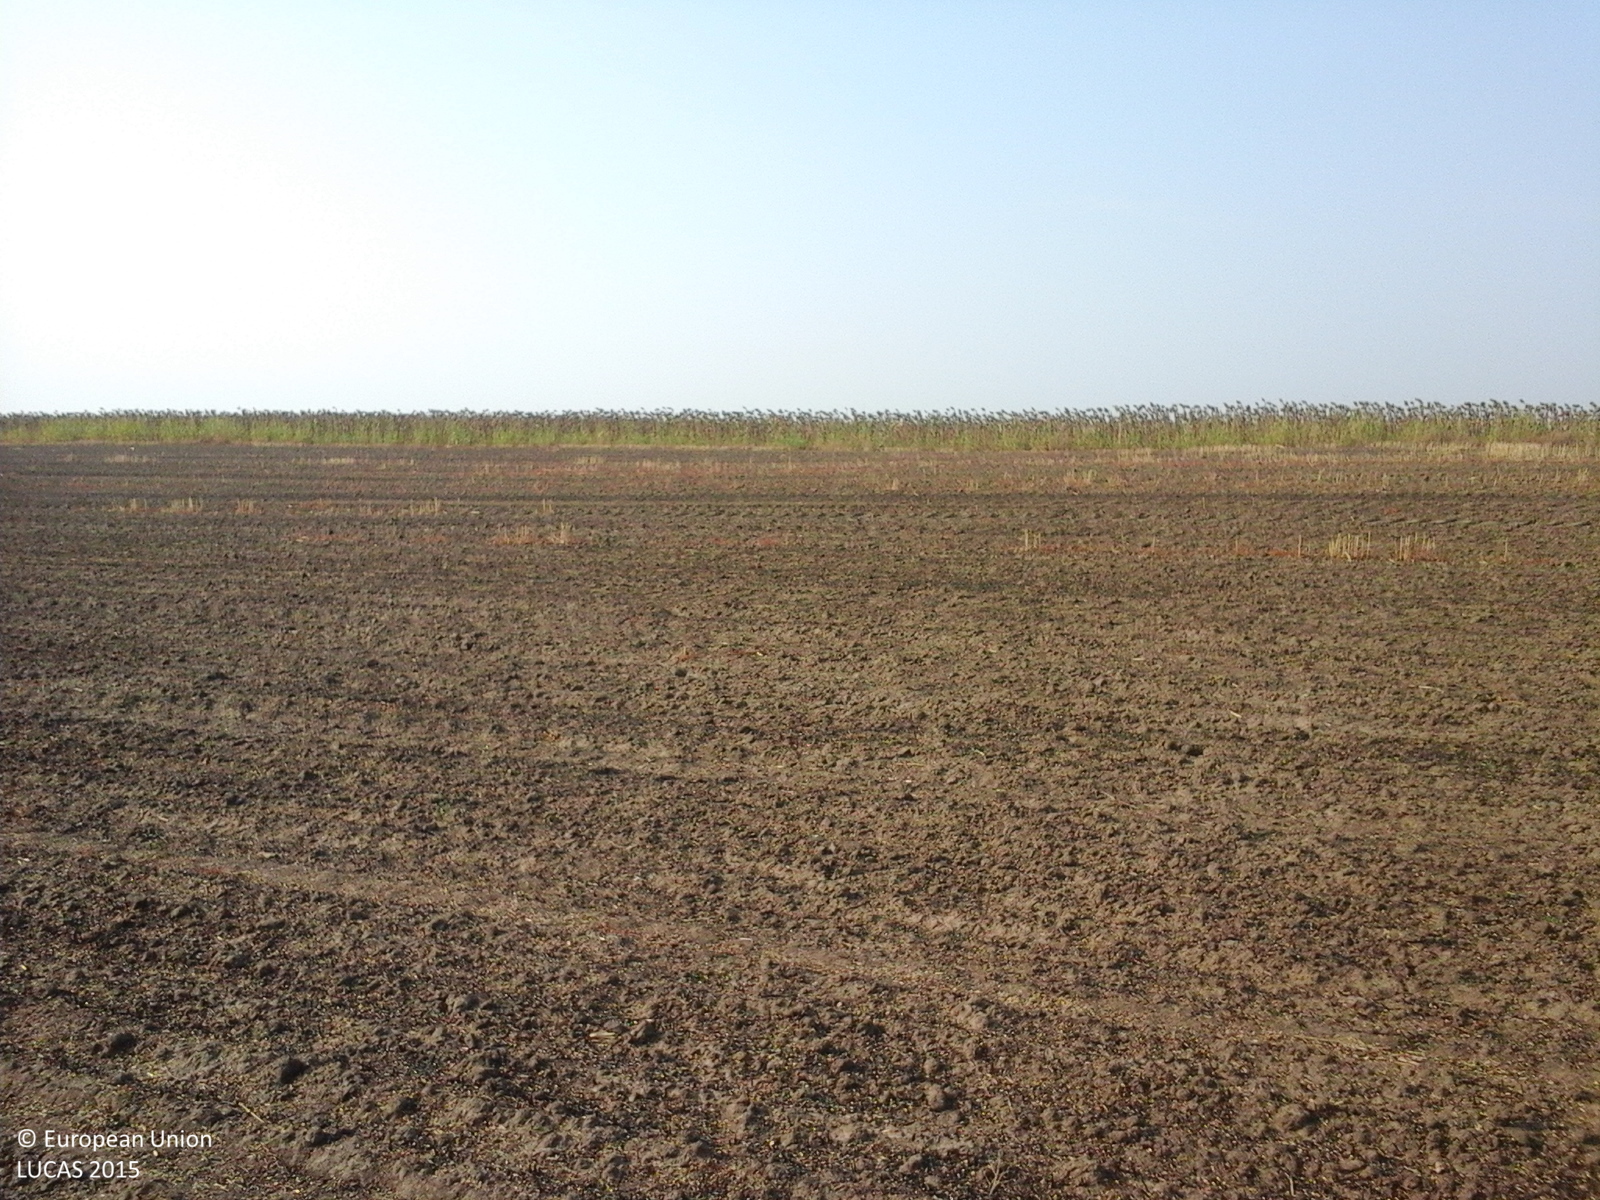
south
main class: Cropland
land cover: Sunflower
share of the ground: > 75 %
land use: Agriculture (excluding fallow land and kitchen gardens)
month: August
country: RO
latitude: 44.1338
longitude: 22.9787
